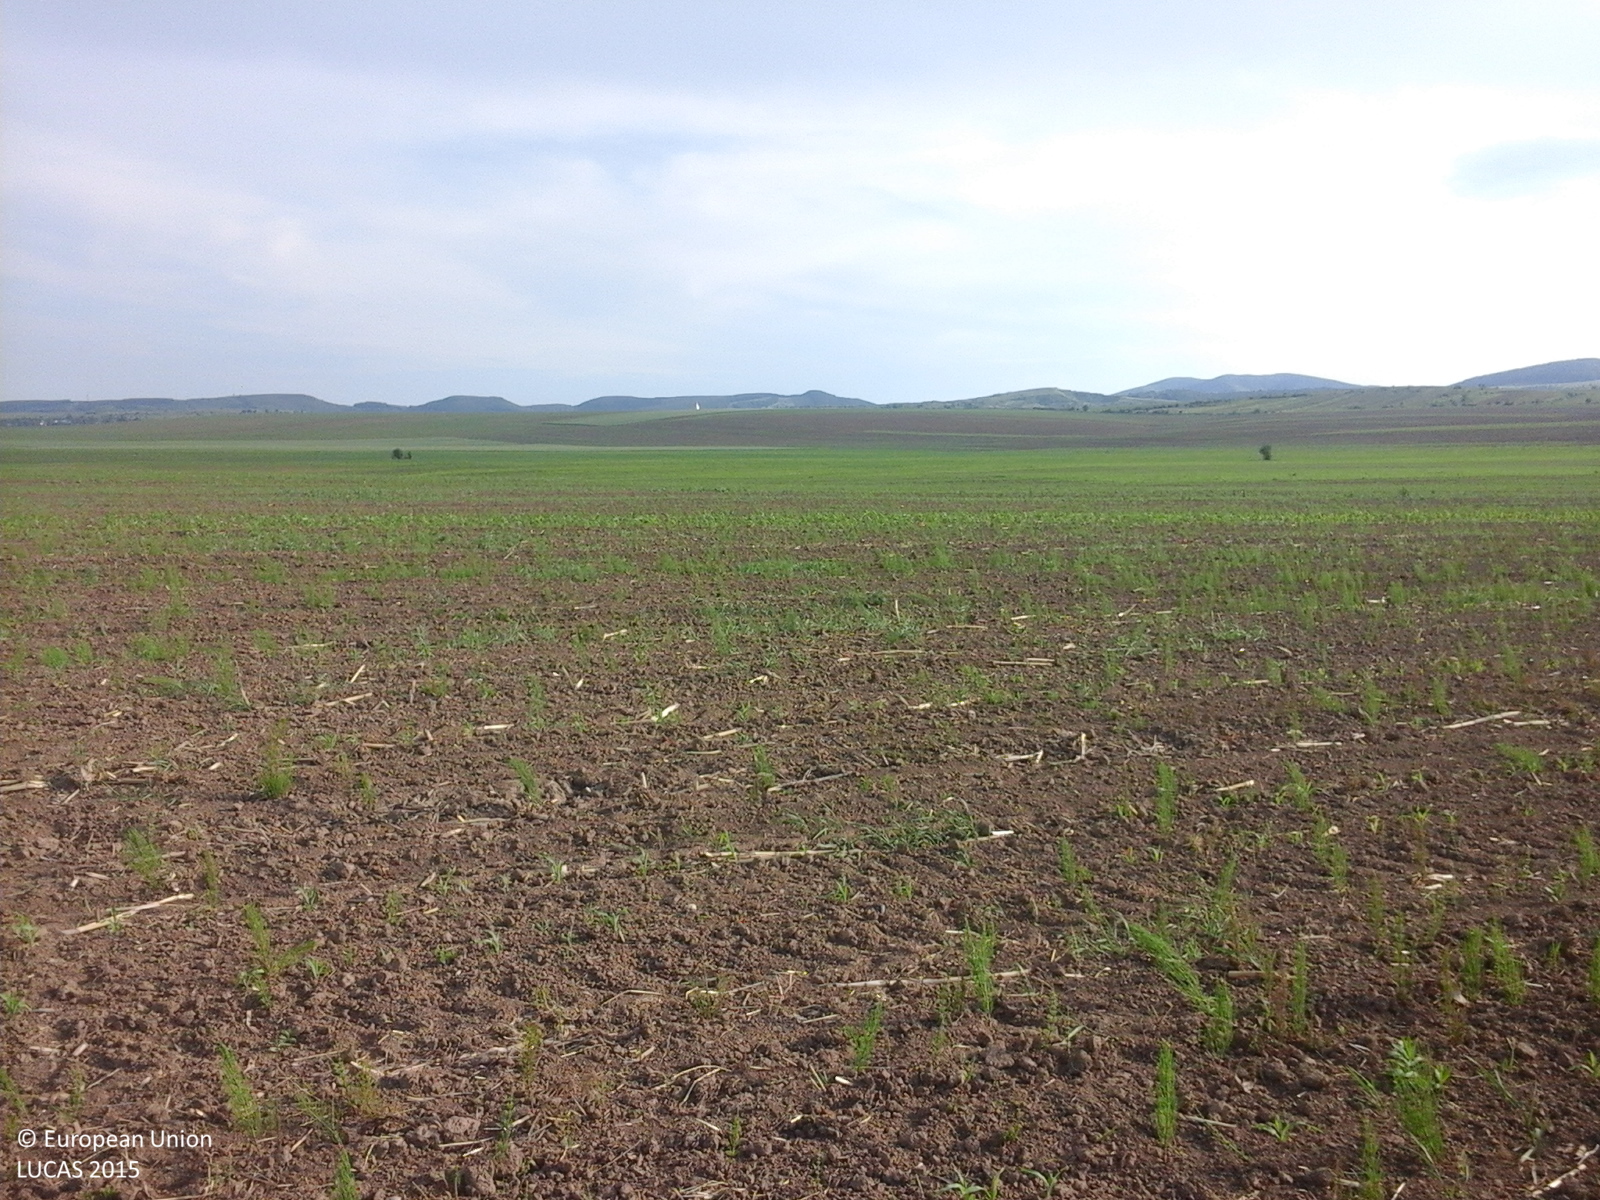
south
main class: Cropland
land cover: Maize
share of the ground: < 10 %
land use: Agriculture (excluding fallow land and kitchen gardens)
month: June
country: RO
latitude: 46.4642
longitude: 26.9039
